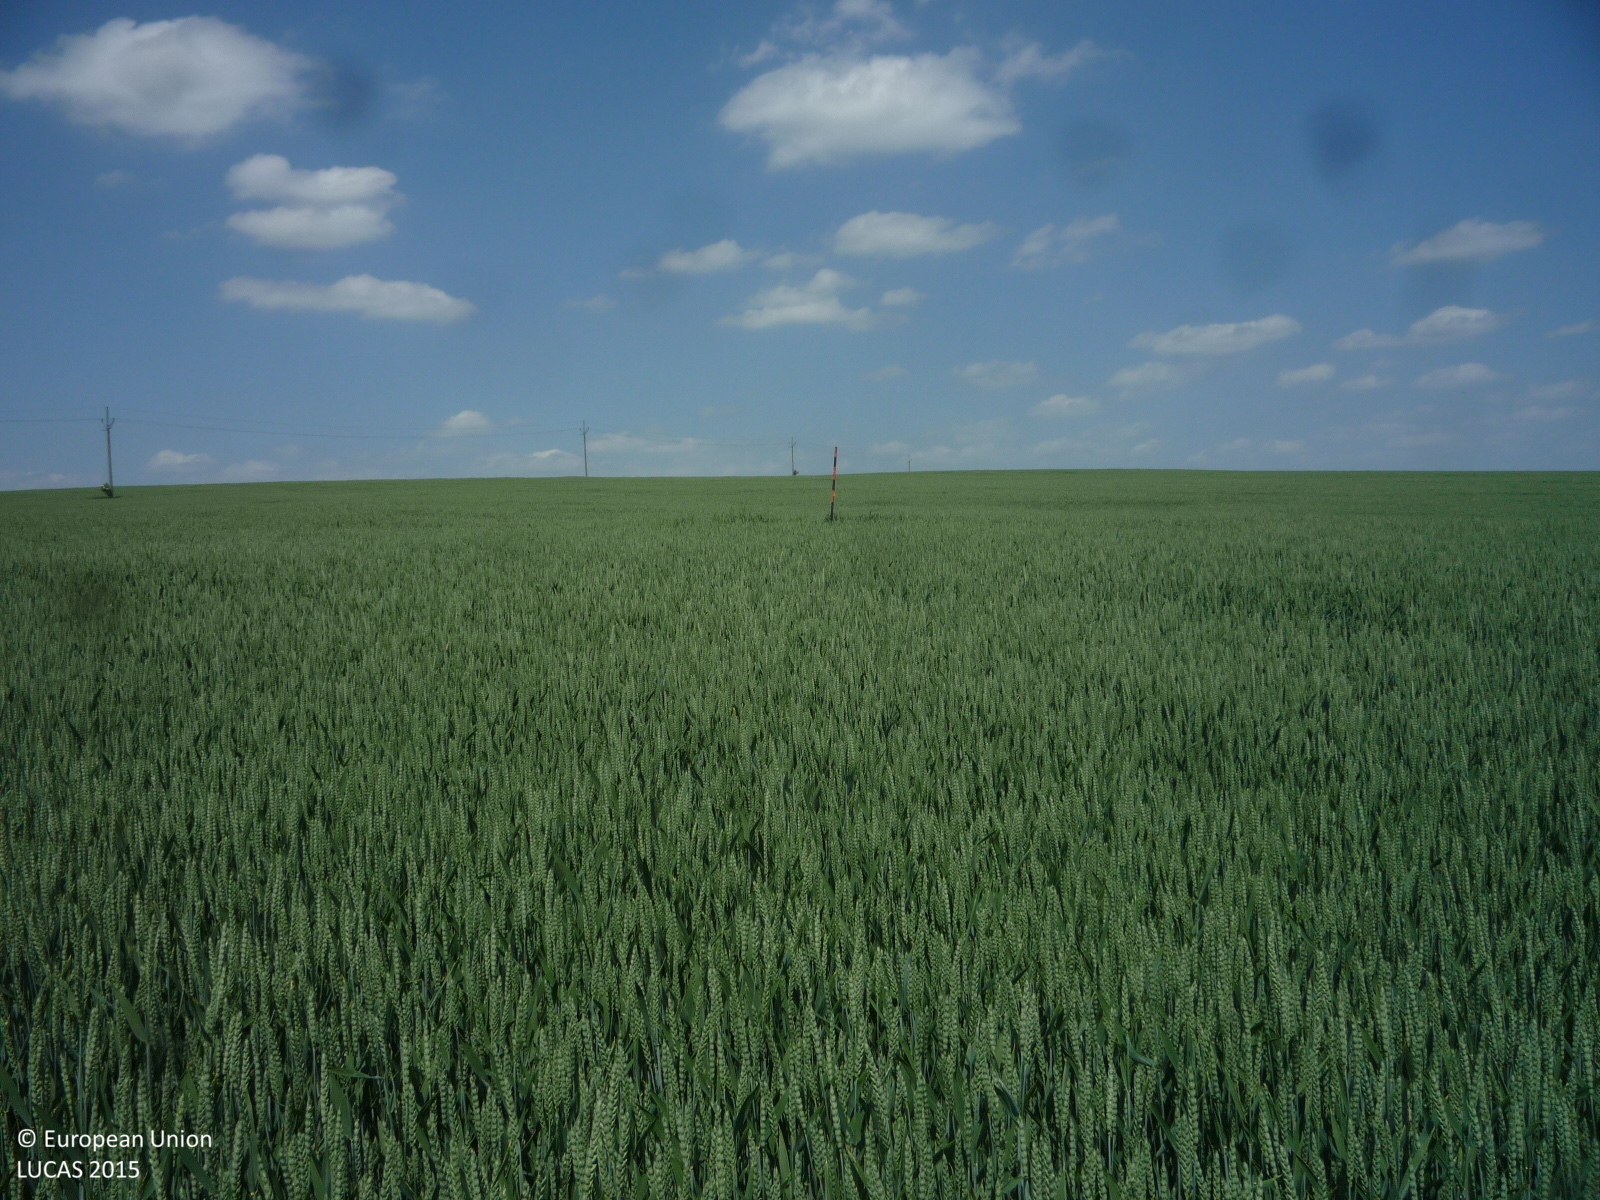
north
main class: Cropland
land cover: Common wheat
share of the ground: > 75 %
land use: Agriculture (excluding fallow land and kitchen gardens)
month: June
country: CZ
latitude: 50.2771
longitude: 13.9720
